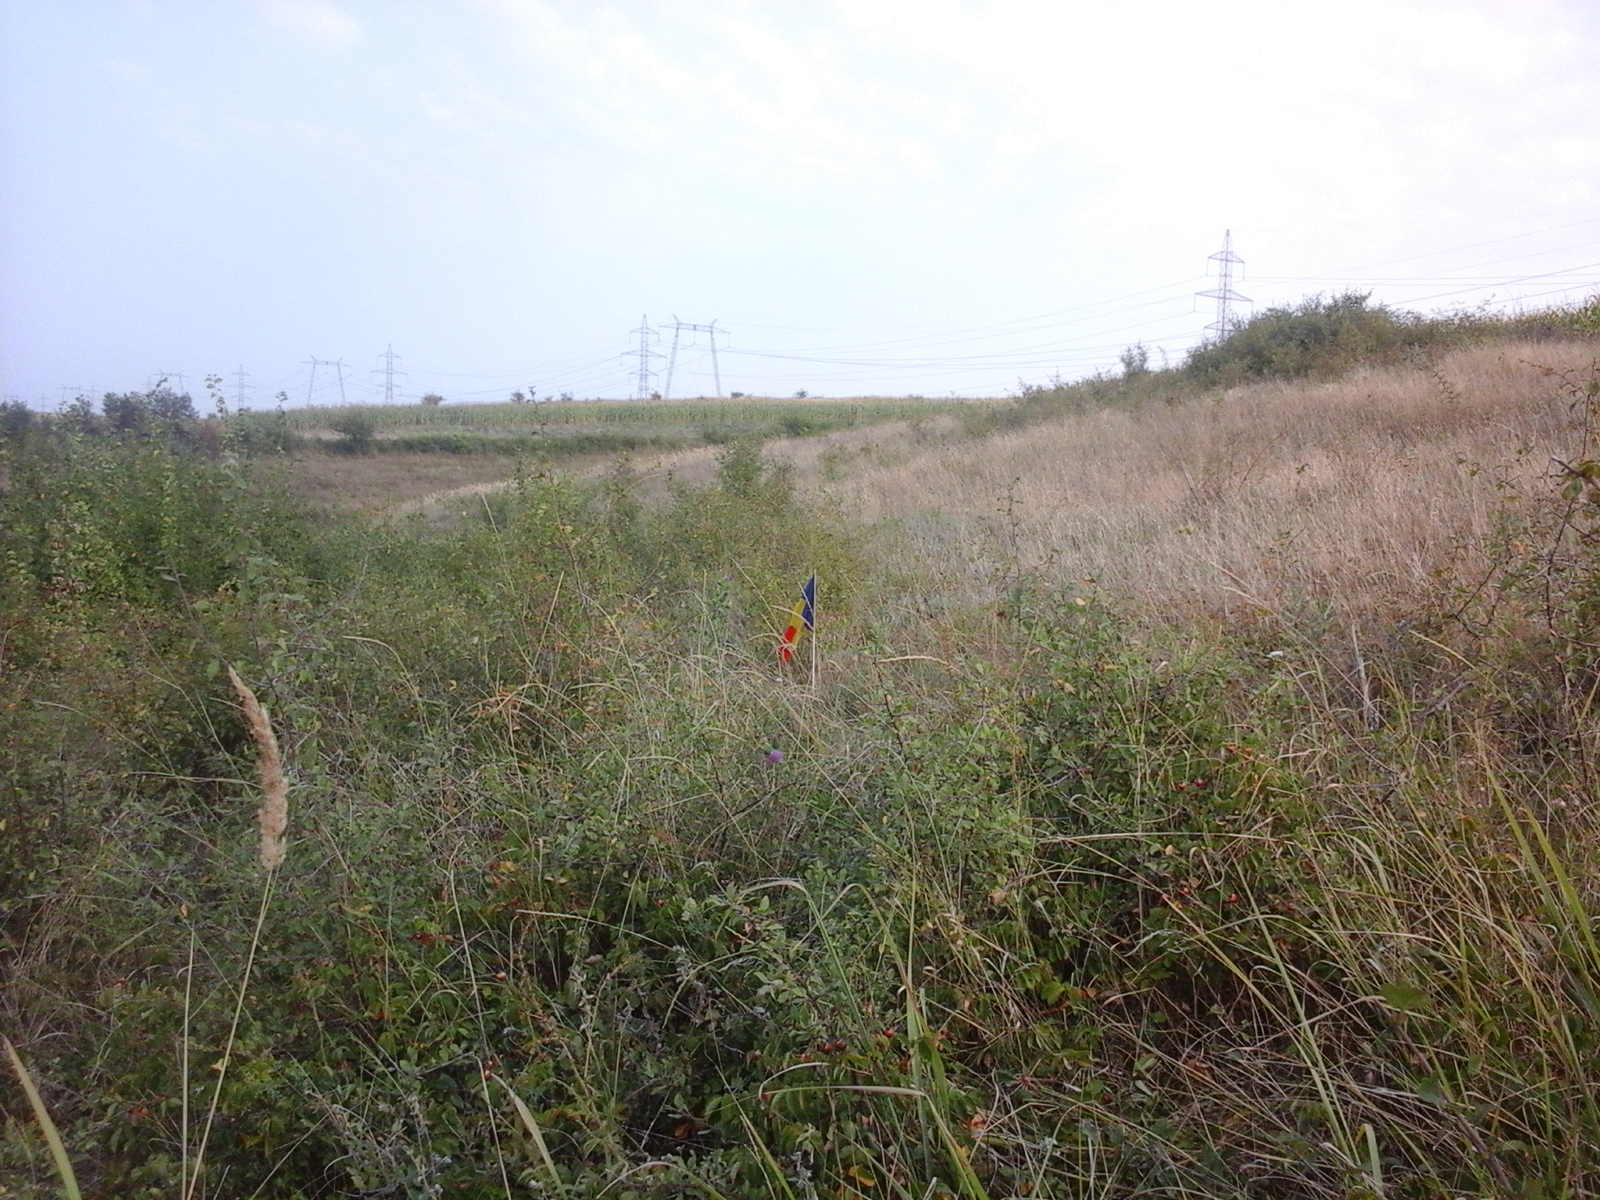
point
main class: Grassland
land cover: Grassland with sparse tree/shrub cover
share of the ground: > 75 %
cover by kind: herbaceous plants 90 %, broadleaved forest trees 5 %, shrubs 5 %
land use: Fallow land
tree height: < 5 m
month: August
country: RO
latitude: 44.4976
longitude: 23.8301
